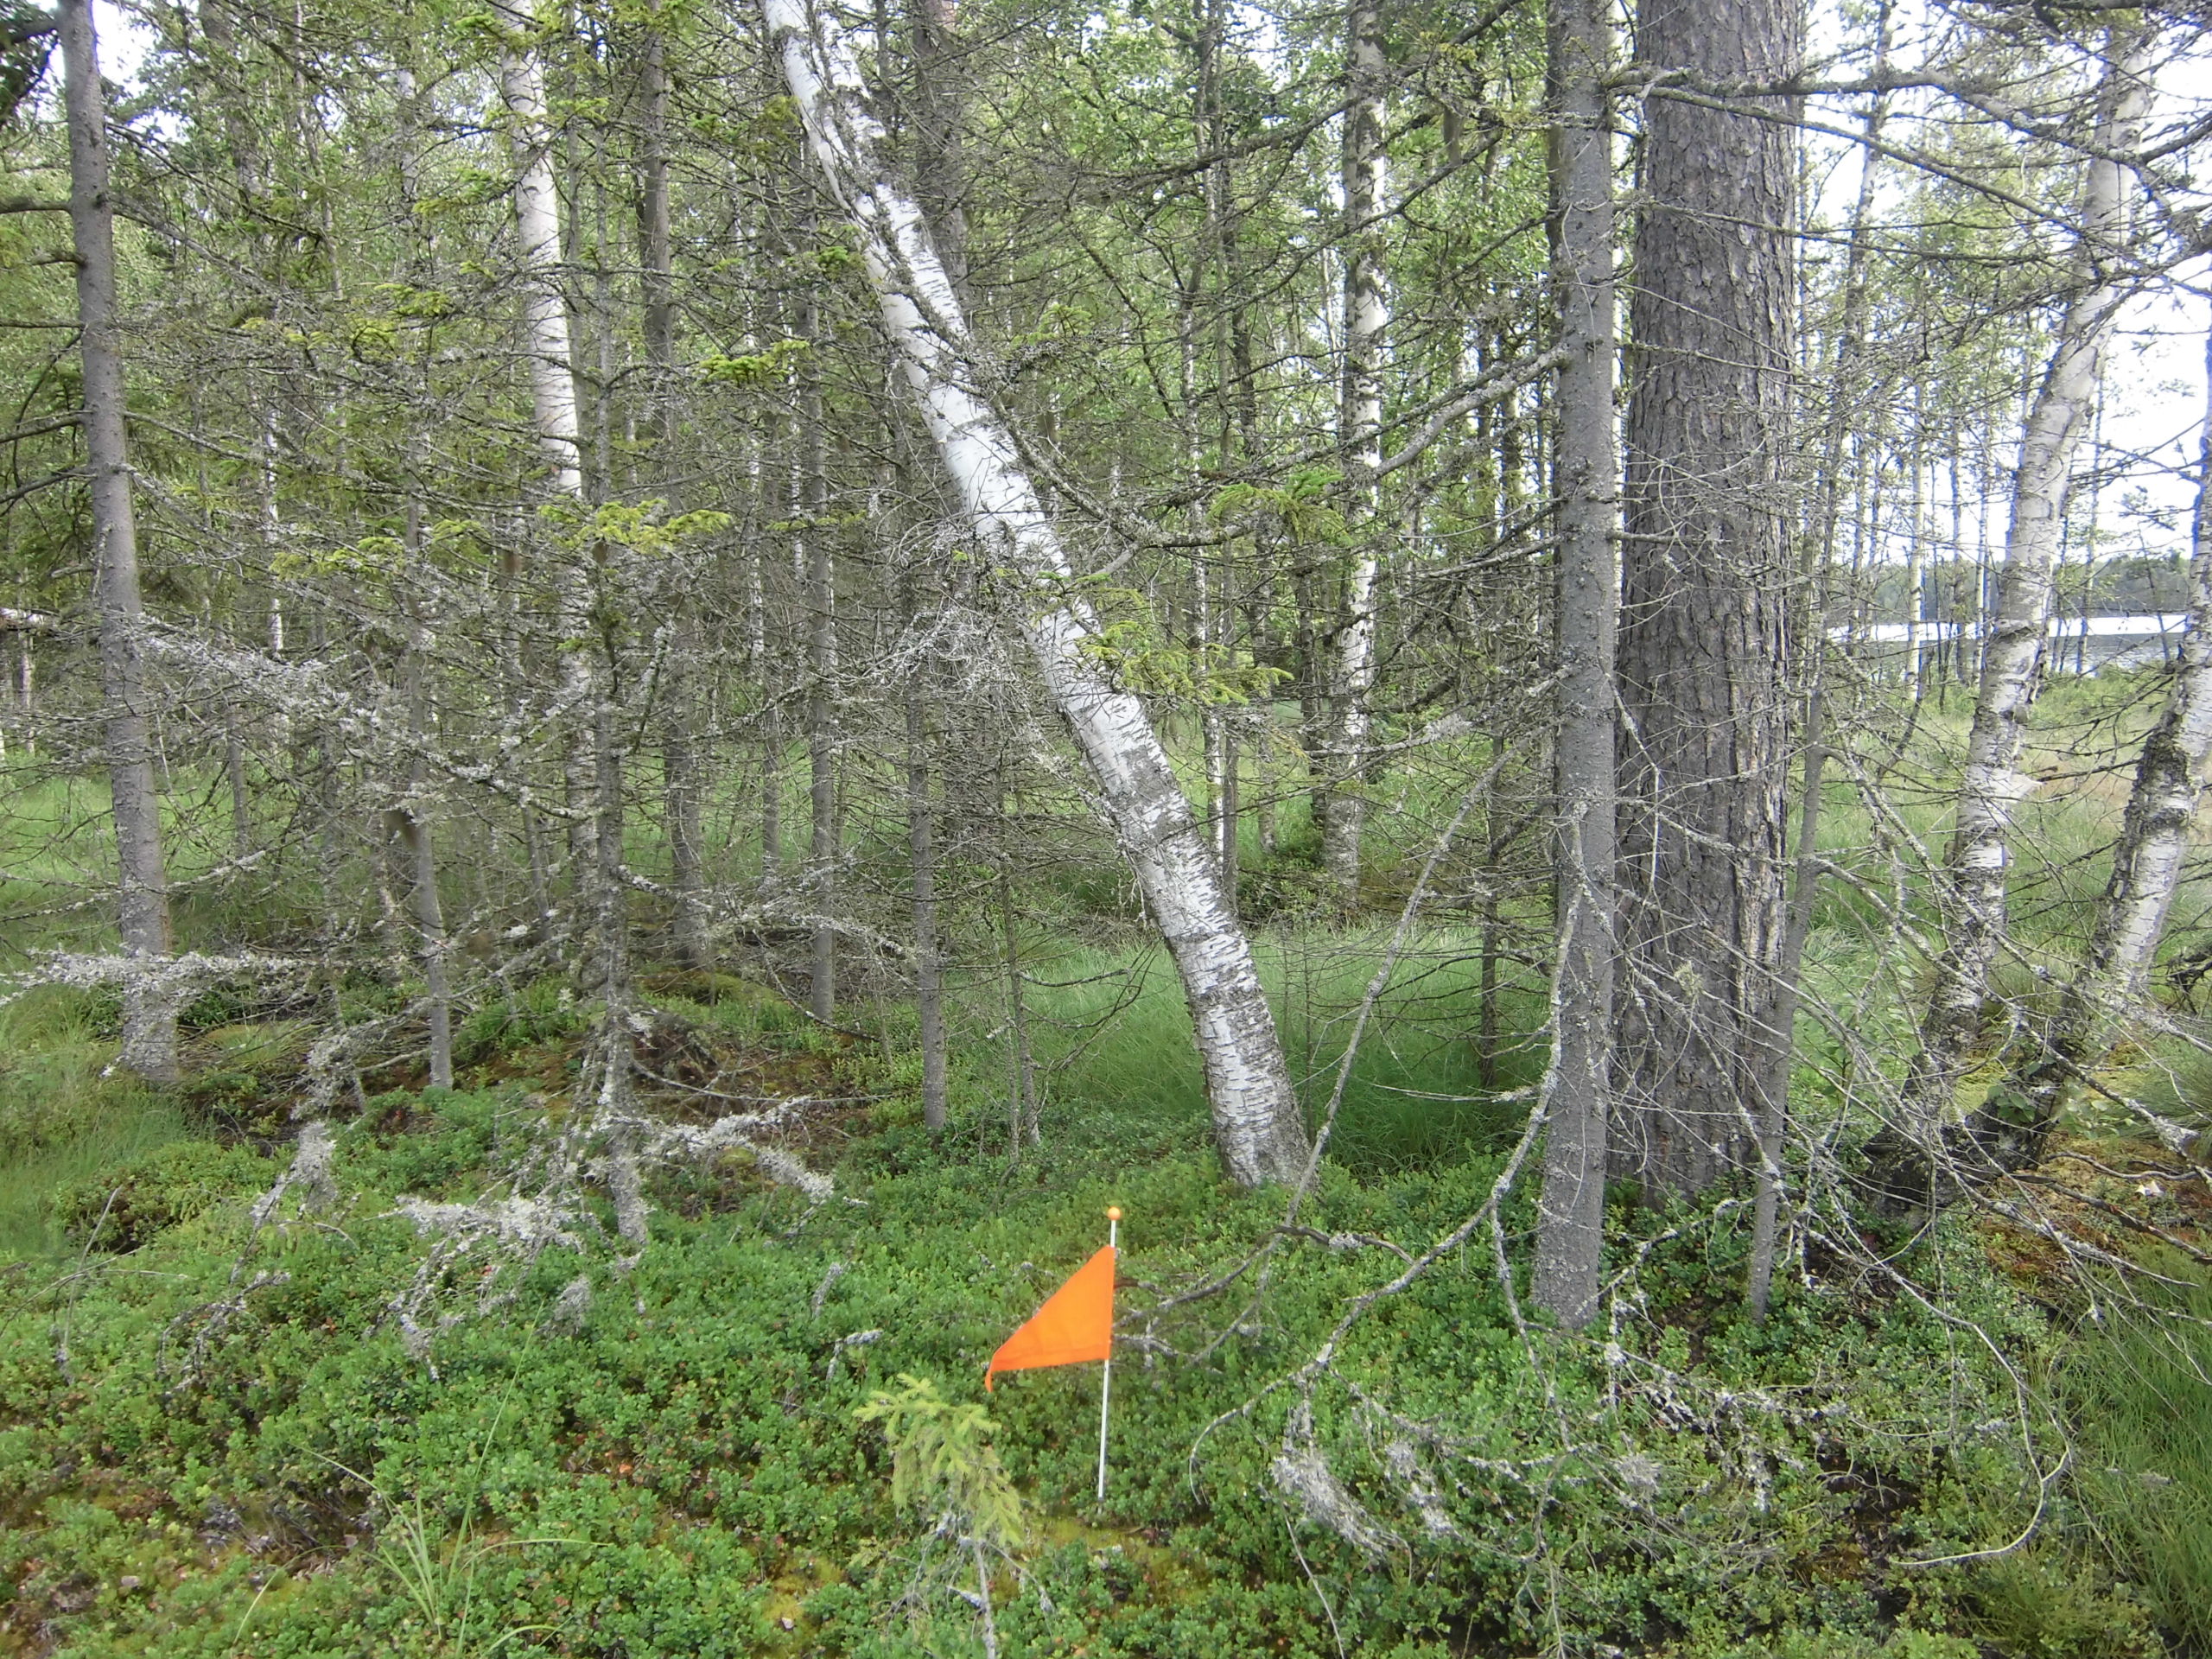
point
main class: Woodland
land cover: Pine dominated mixed woodland
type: boreal forest
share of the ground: 50 - 75 %
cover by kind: shrubs 35 %, broadleaved forest trees 30 %, coniferous forest trees 20 %, herbaceous plants 10 %, lichens and mosses 5 %
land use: Forestry
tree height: > 5 m
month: July
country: SE
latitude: 57.1209
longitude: 15.3652
